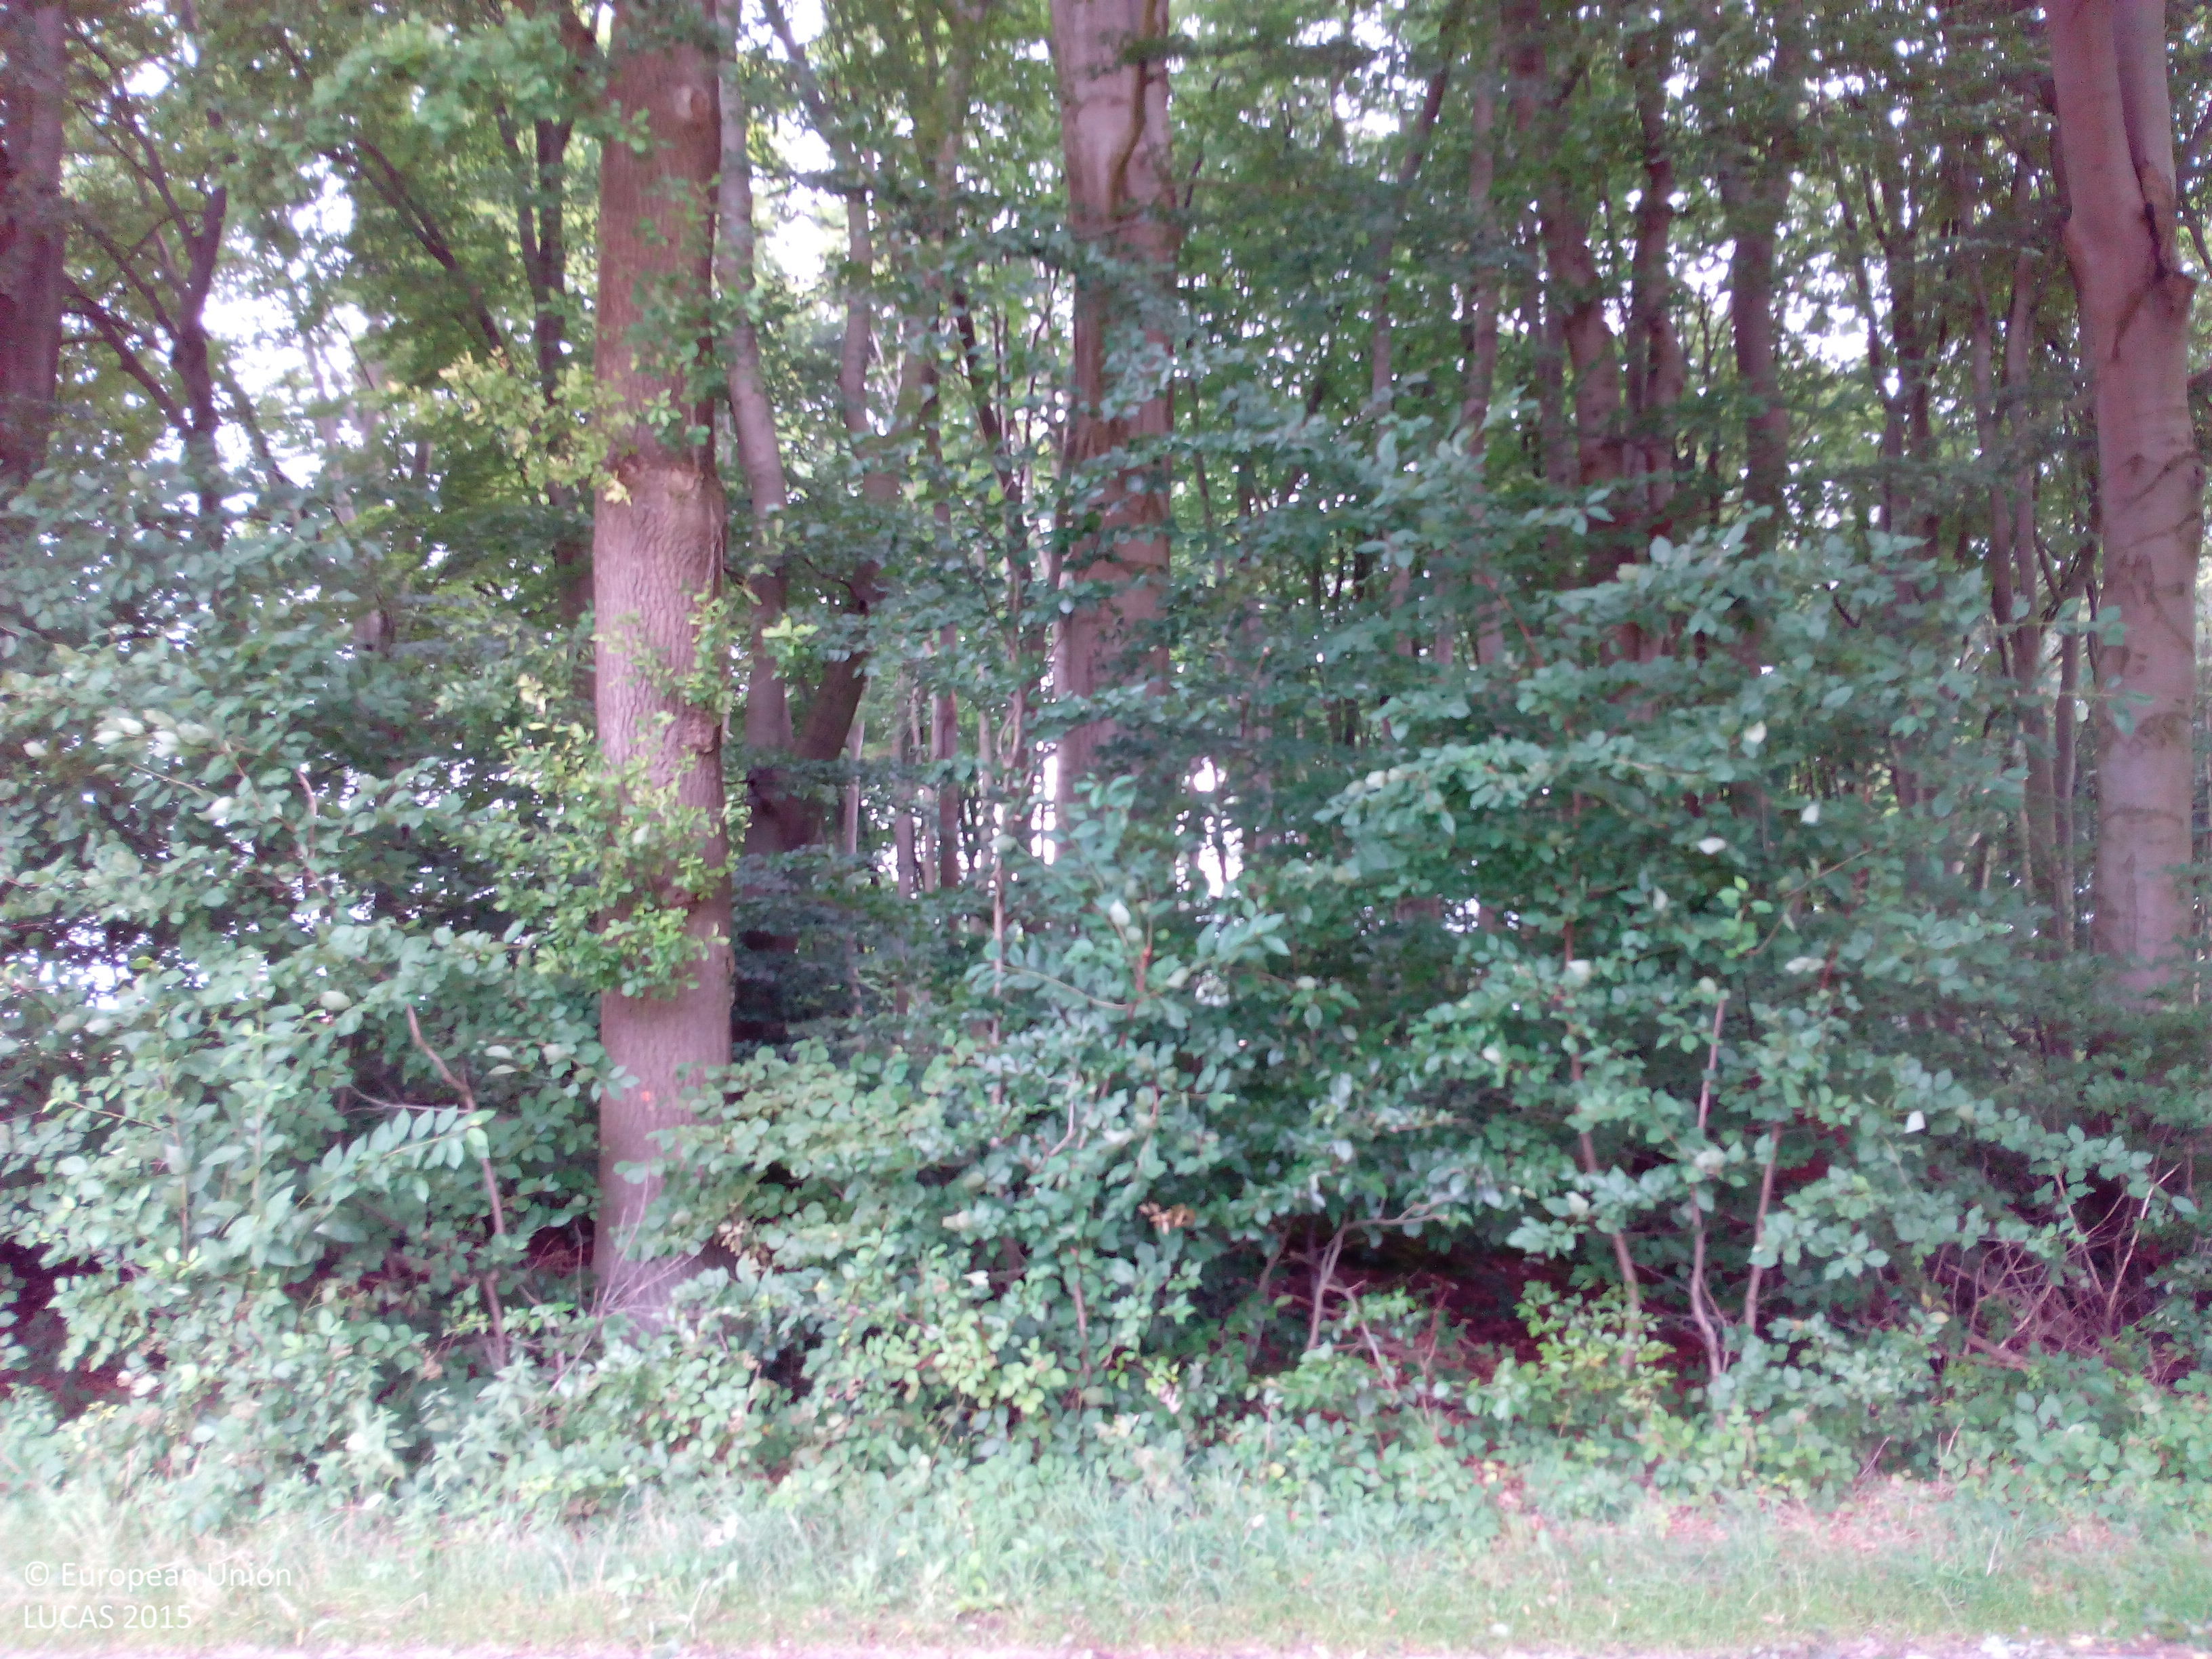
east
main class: Cropland
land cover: Triticale
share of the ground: > 75 %
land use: Agriculture (excluding fallow land and kitchen gardens)
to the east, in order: Triticale; Fences; Grassland without tree/shrub cover; Fences; Lines of trees; Paved roads, cycling and walking lanes; Broadleaved woodland; Tracks; Triticale
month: July
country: DE
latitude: 52.3425
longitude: 7.9895
